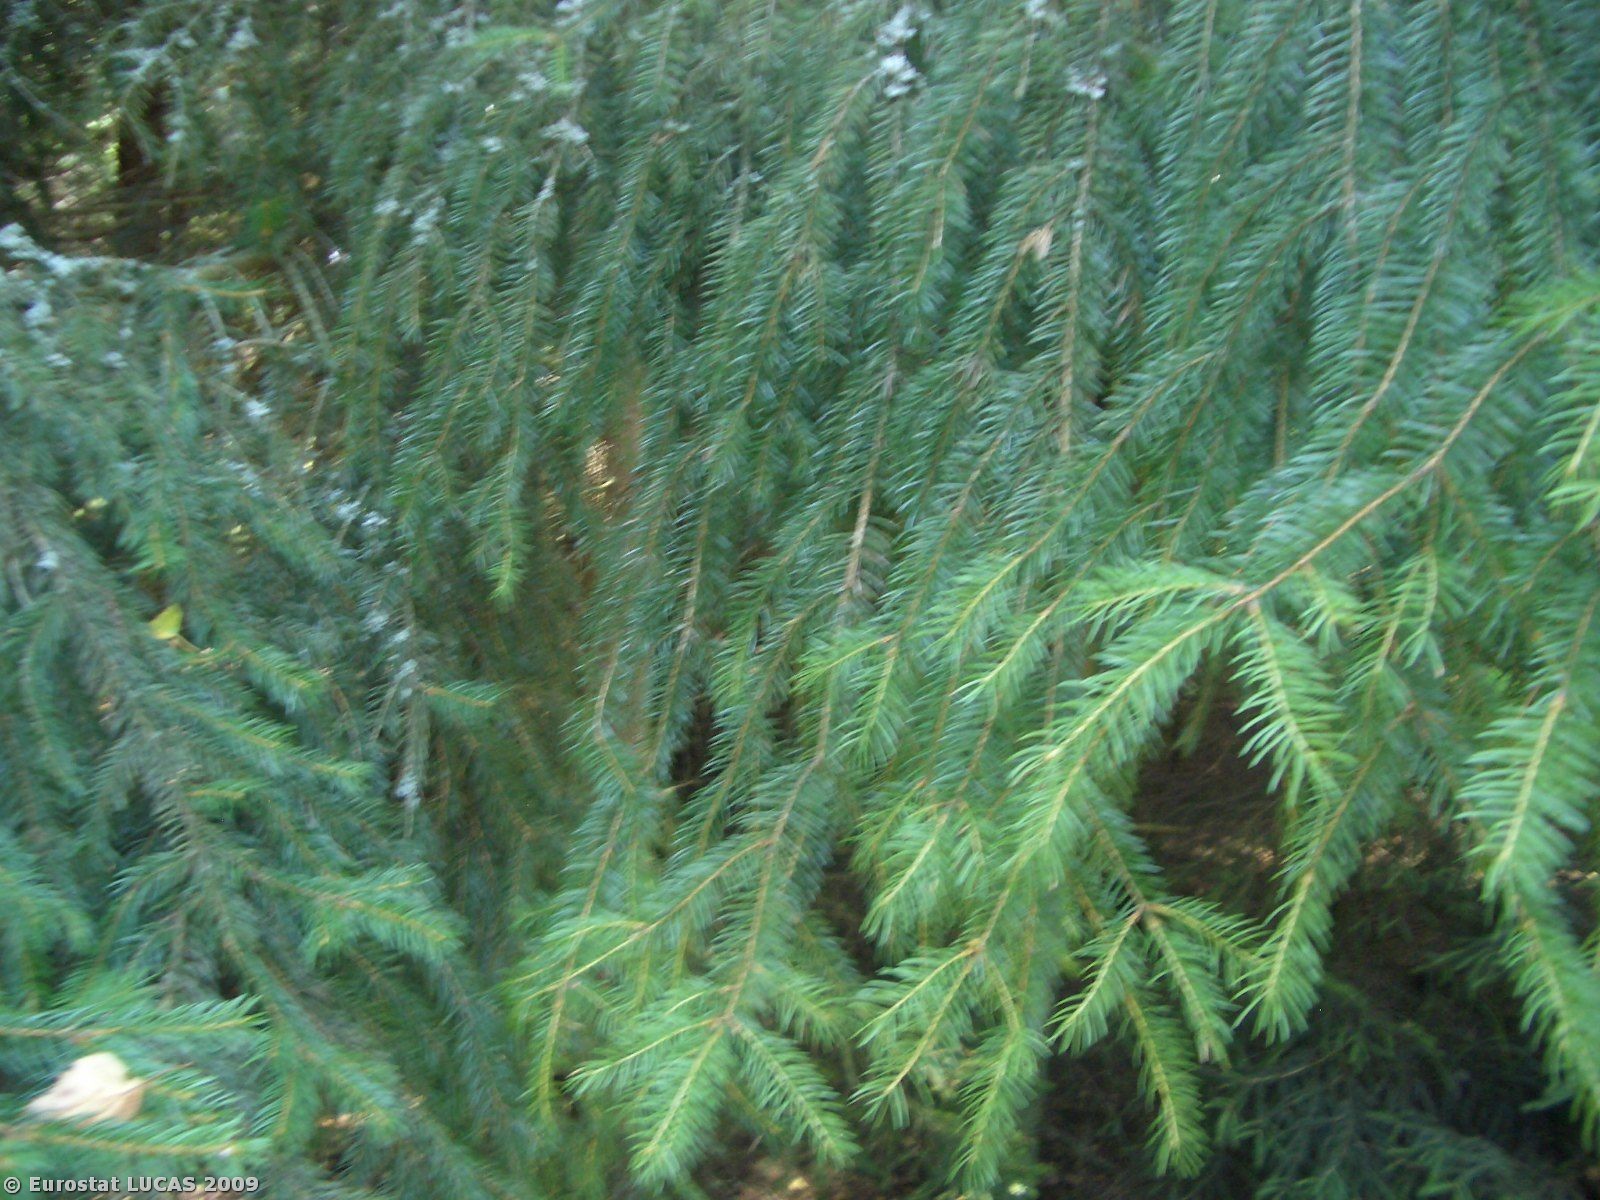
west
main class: Woodland
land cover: Mixed woodland
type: hemiboreal forest and nemoral coniferous forest and mixed broadleaved-coniferous forest
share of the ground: > 75 %
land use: Forestry
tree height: > 5 m
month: July
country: PL
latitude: 51.5177
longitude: 23.1193
